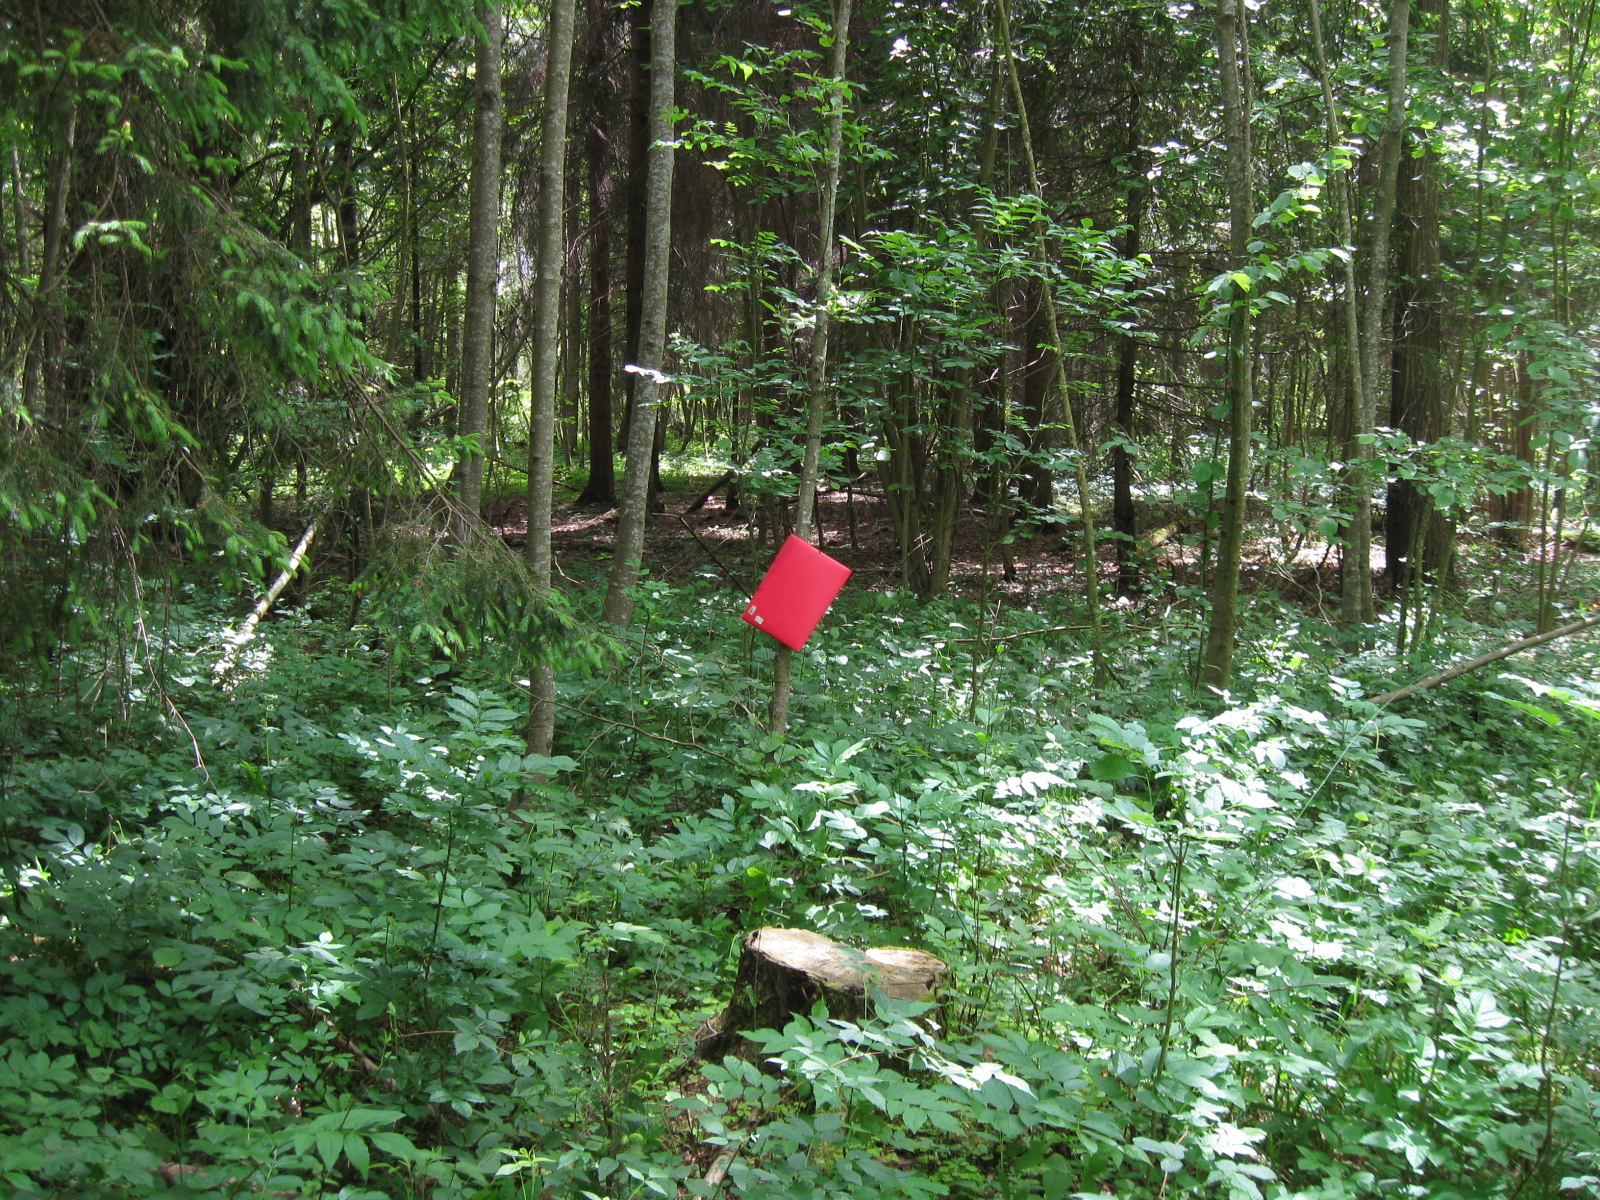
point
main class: Woodland
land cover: Spruce dominated mixed woodland
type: hemiboreal forest and nemoral coniferous forest and mixed broadleaved-coniferous forest
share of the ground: > 75 %
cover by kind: broadleaved forest trees 55 %, coniferous forest trees 35 %, herbaceous plants 10 %
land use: Forestry
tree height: > 5 m
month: June
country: LT
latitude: 55.0309
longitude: 23.8393
